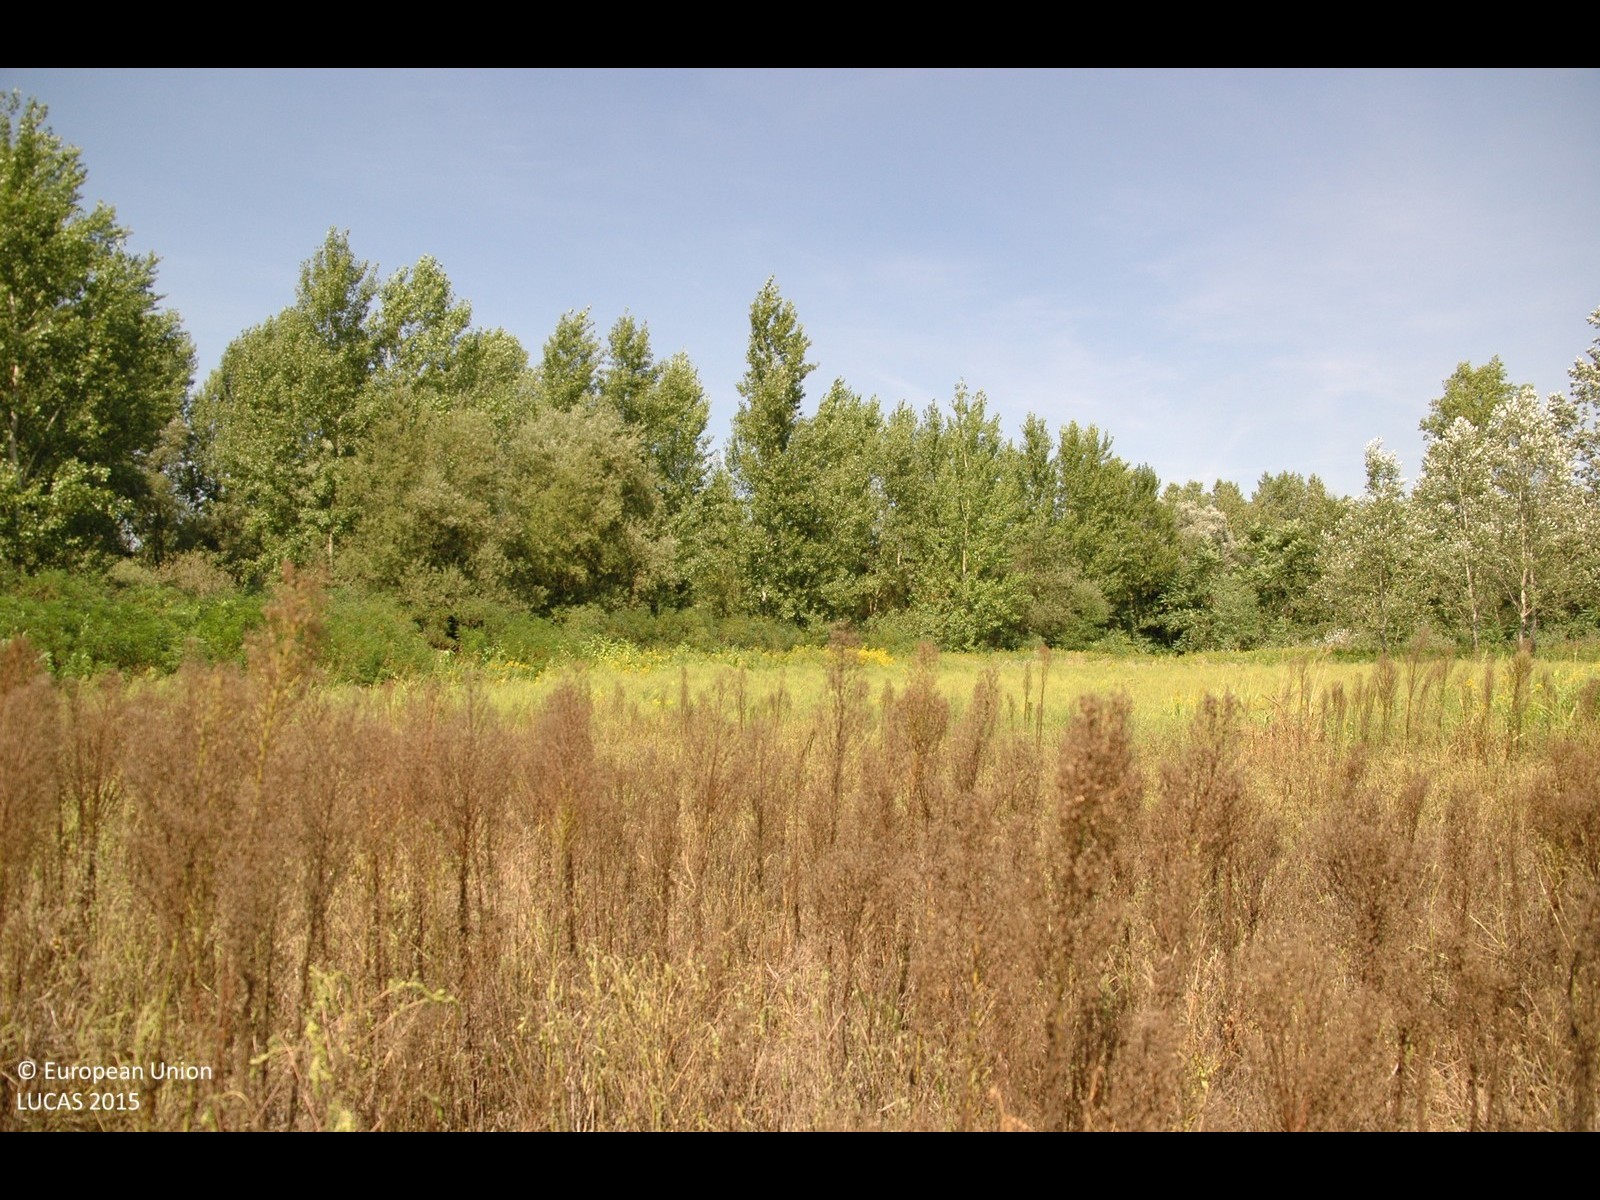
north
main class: Grassland
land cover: Spontaneously vegetated surfaces
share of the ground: > 75 %
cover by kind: herbaceous plants 100 %
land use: Fallow land
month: August
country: HR
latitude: 46.2979
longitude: 16.7912
